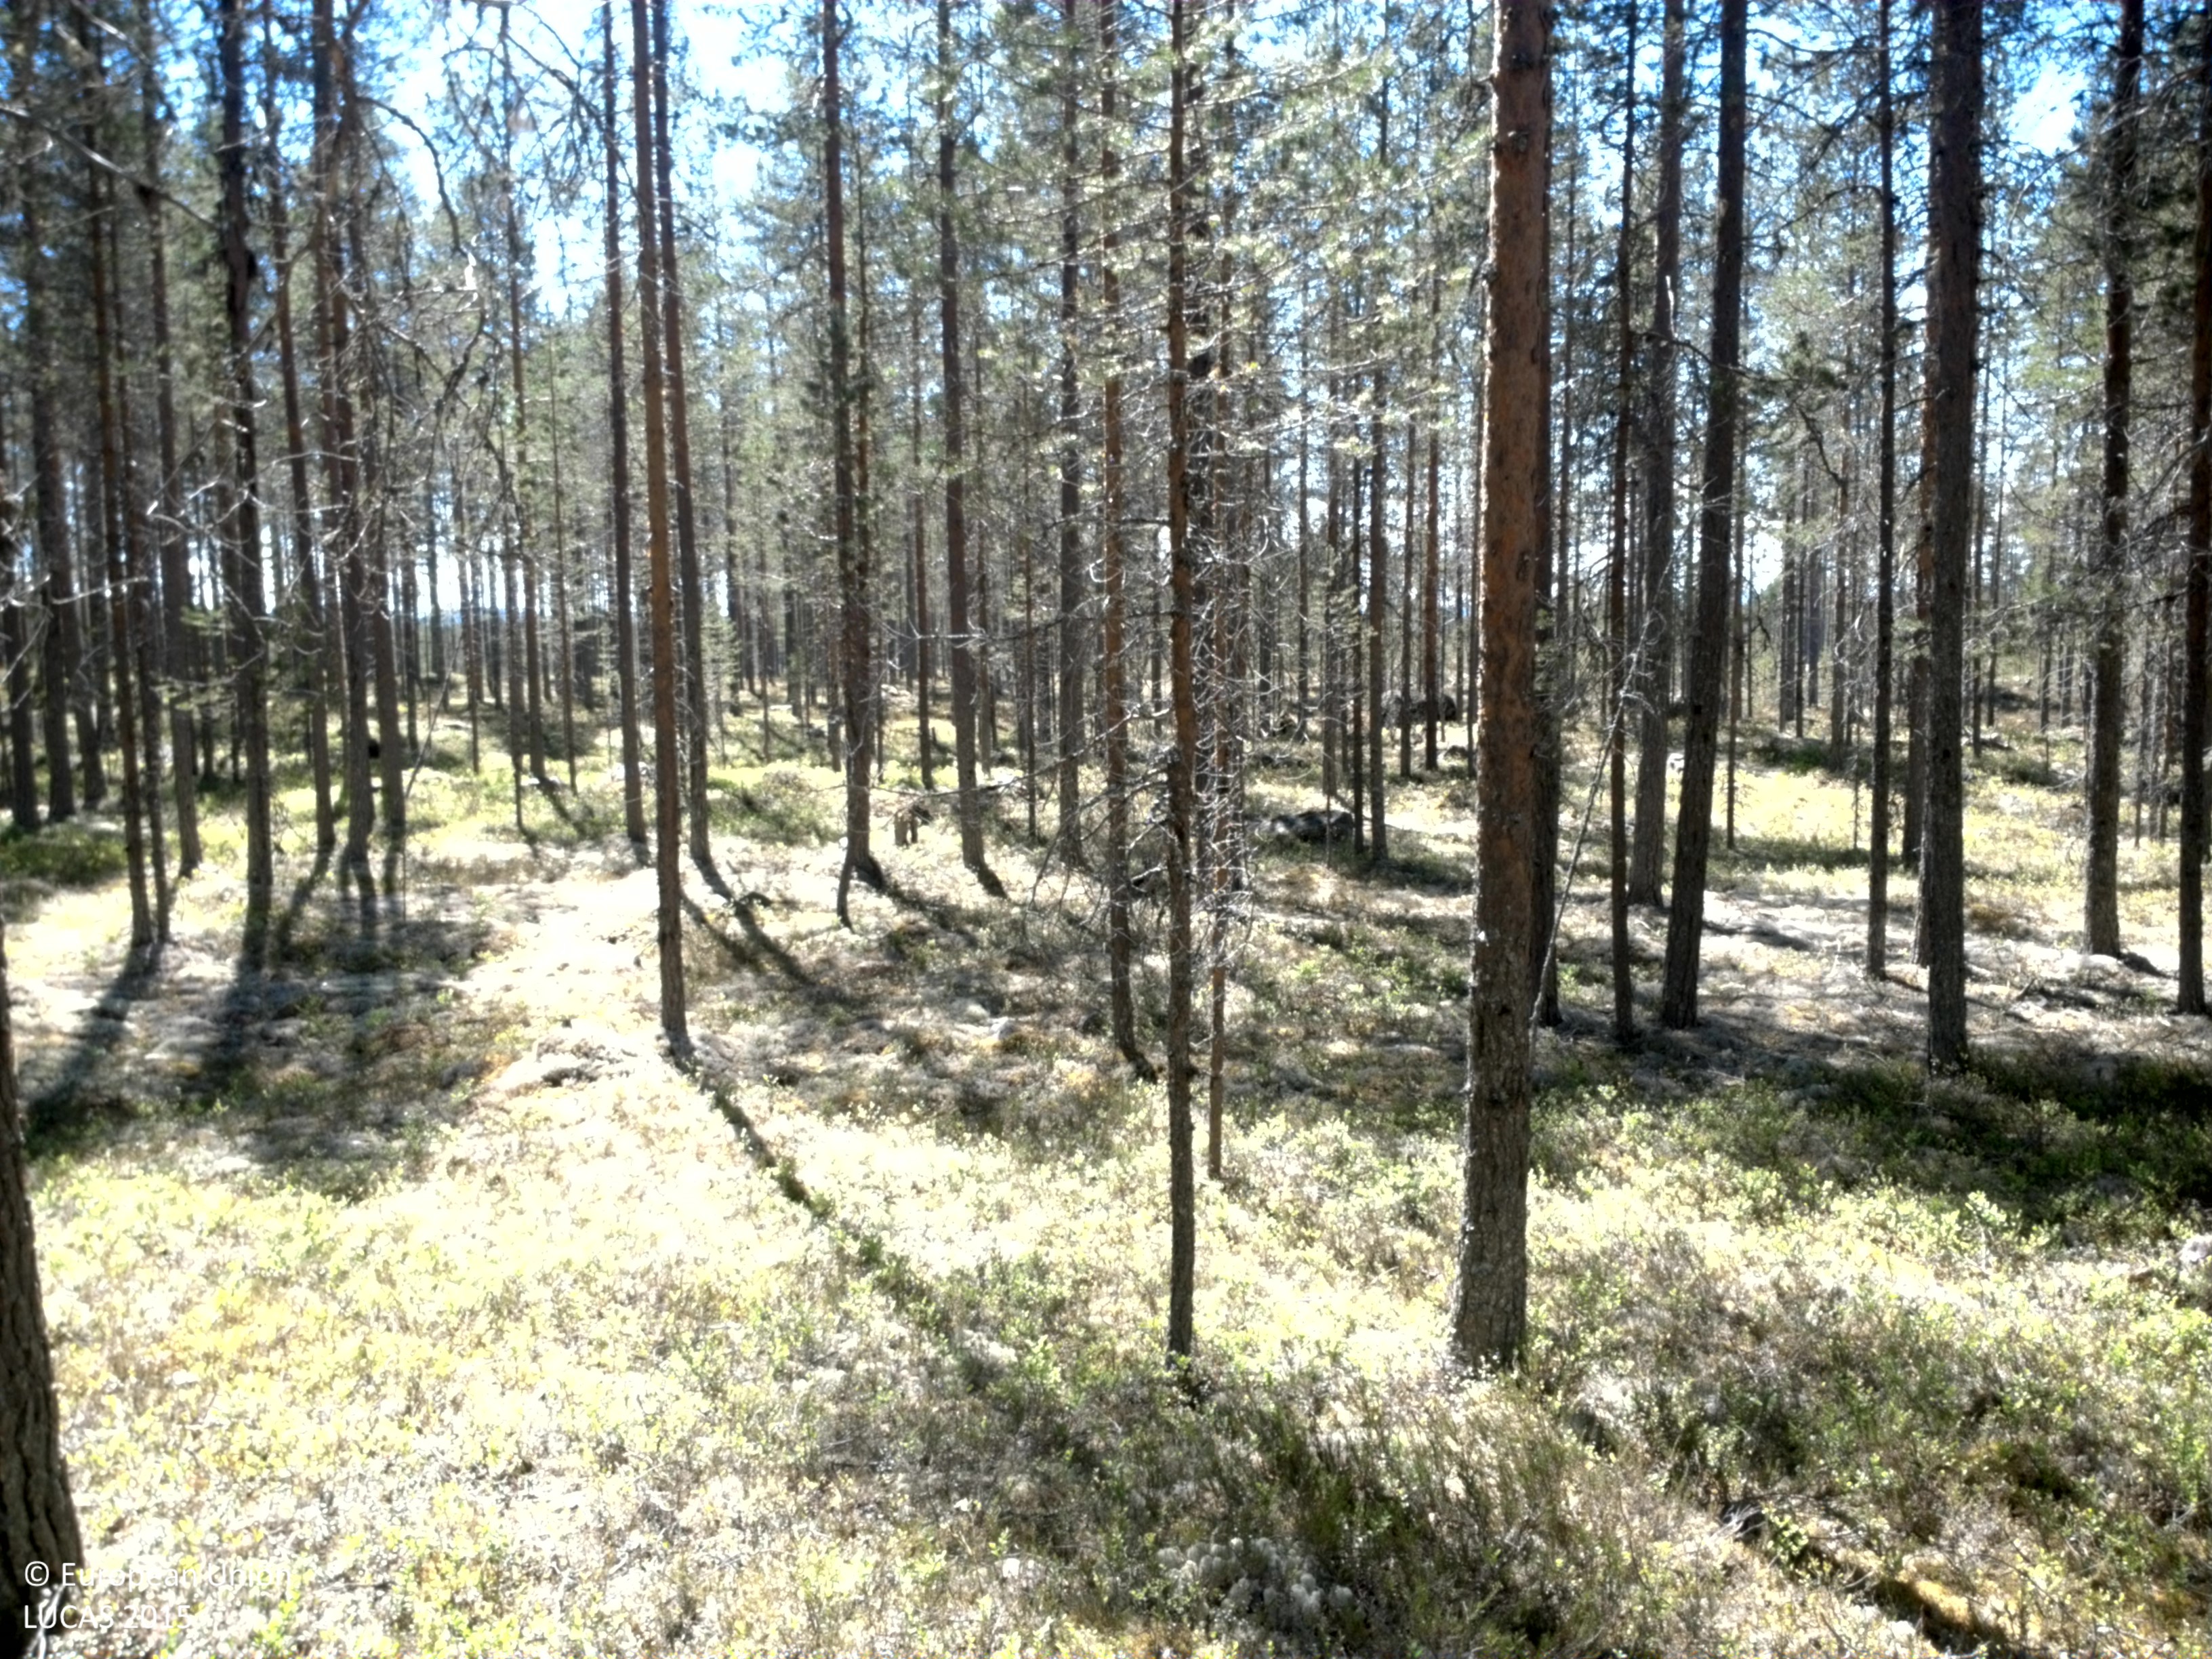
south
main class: Woodland
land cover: Pine dominated coniferous woodland
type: boreal forest
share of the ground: > 75 %
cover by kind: coniferous forest trees 75 %, herbaceous plants 15 %, lichens and mosses 10 %
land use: Forestry
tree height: > 5 m
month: June
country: SE
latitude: 61.3957
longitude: 13.6384
